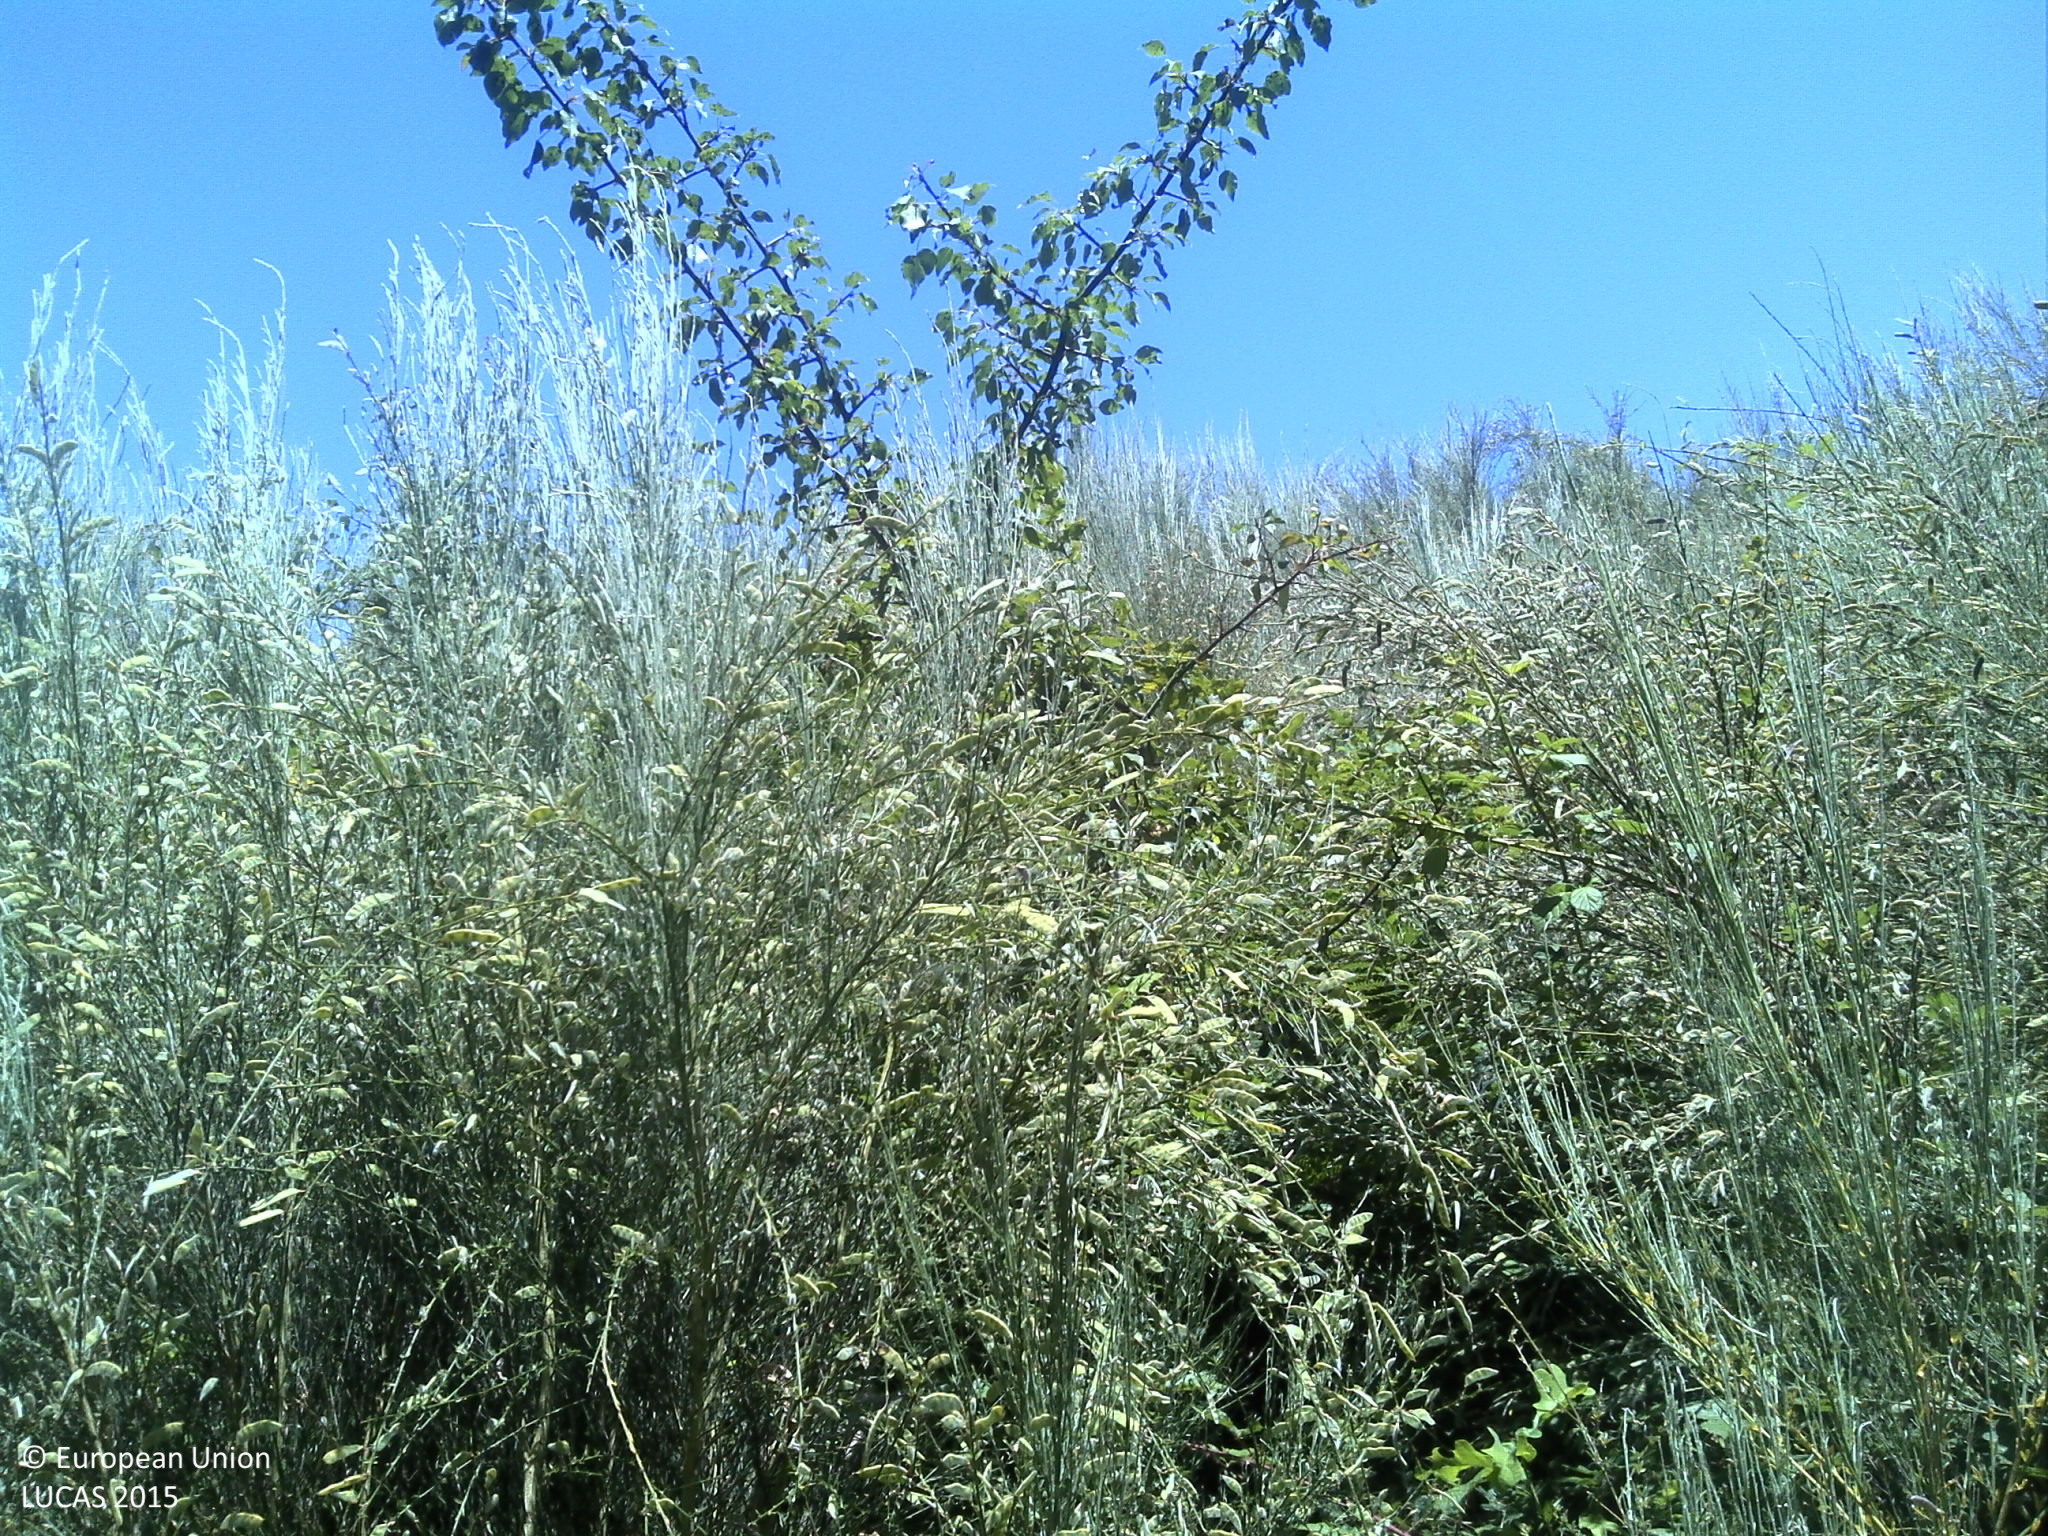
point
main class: Shrubland
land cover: Shrubland without tree cover
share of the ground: > 75 %
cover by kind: shrubs 85 %, unconsolidated bare surface 10 %, herbaceous plants 5 %
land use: Semi-natural and natural areas not in use
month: June
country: PT
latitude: 41.4003
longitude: -8.0709
